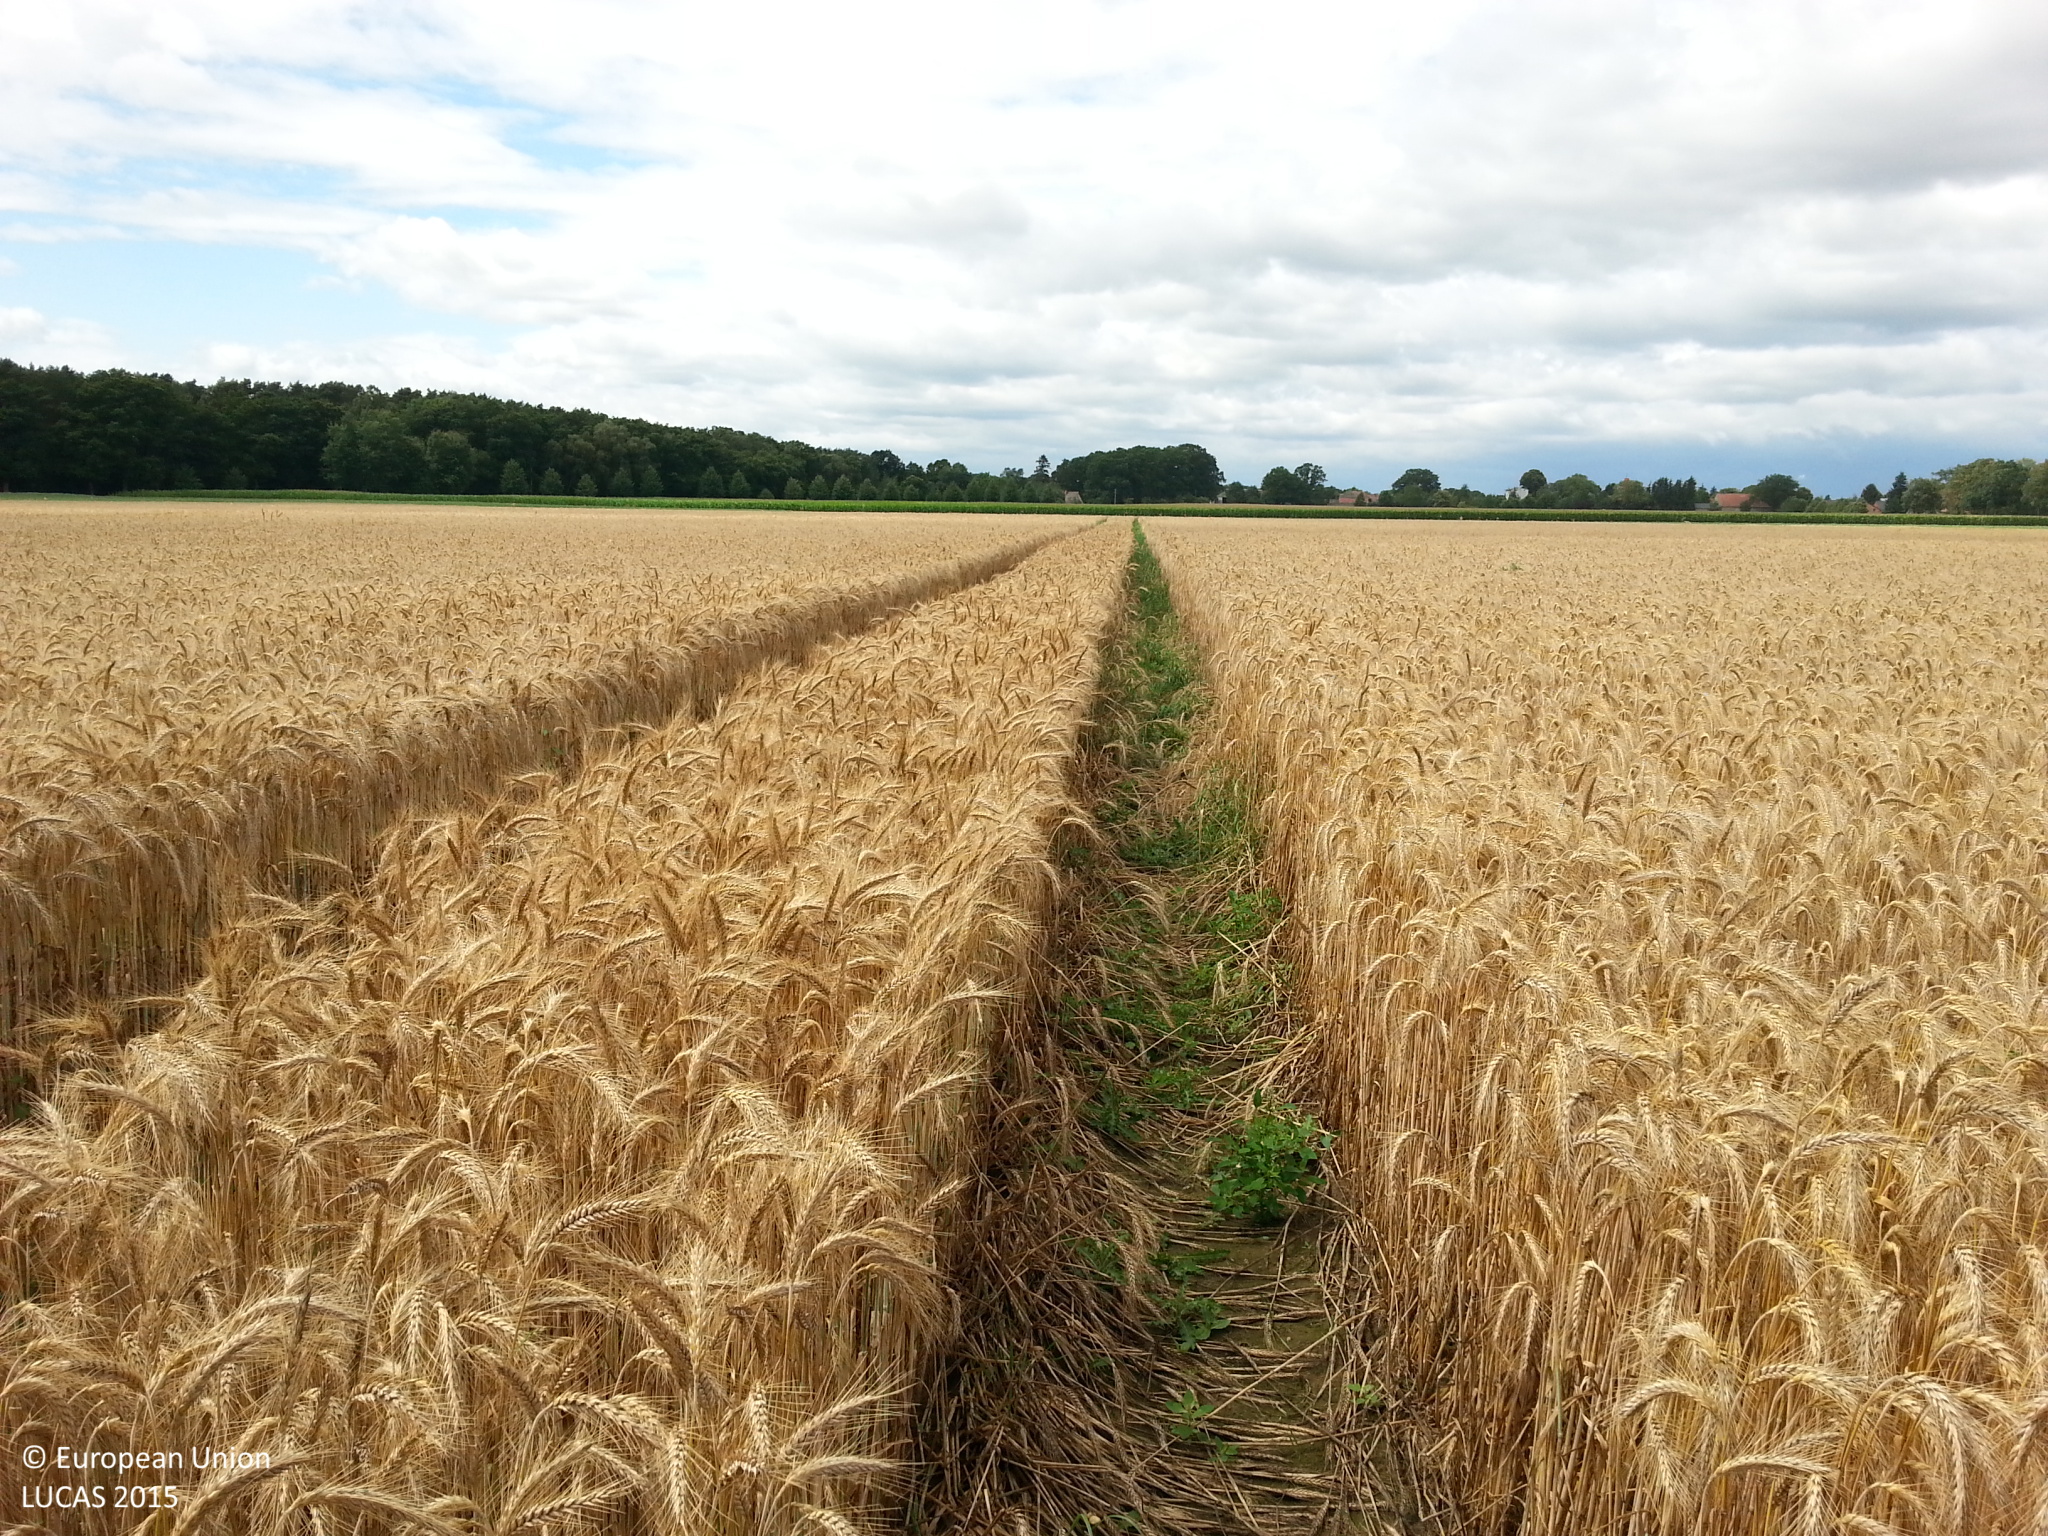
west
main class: Cropland
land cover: Barley
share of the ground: > 75 %
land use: Agriculture (excluding fallow land and kitchen gardens)
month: July
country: DE
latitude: 53.1393
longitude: 11.6288
